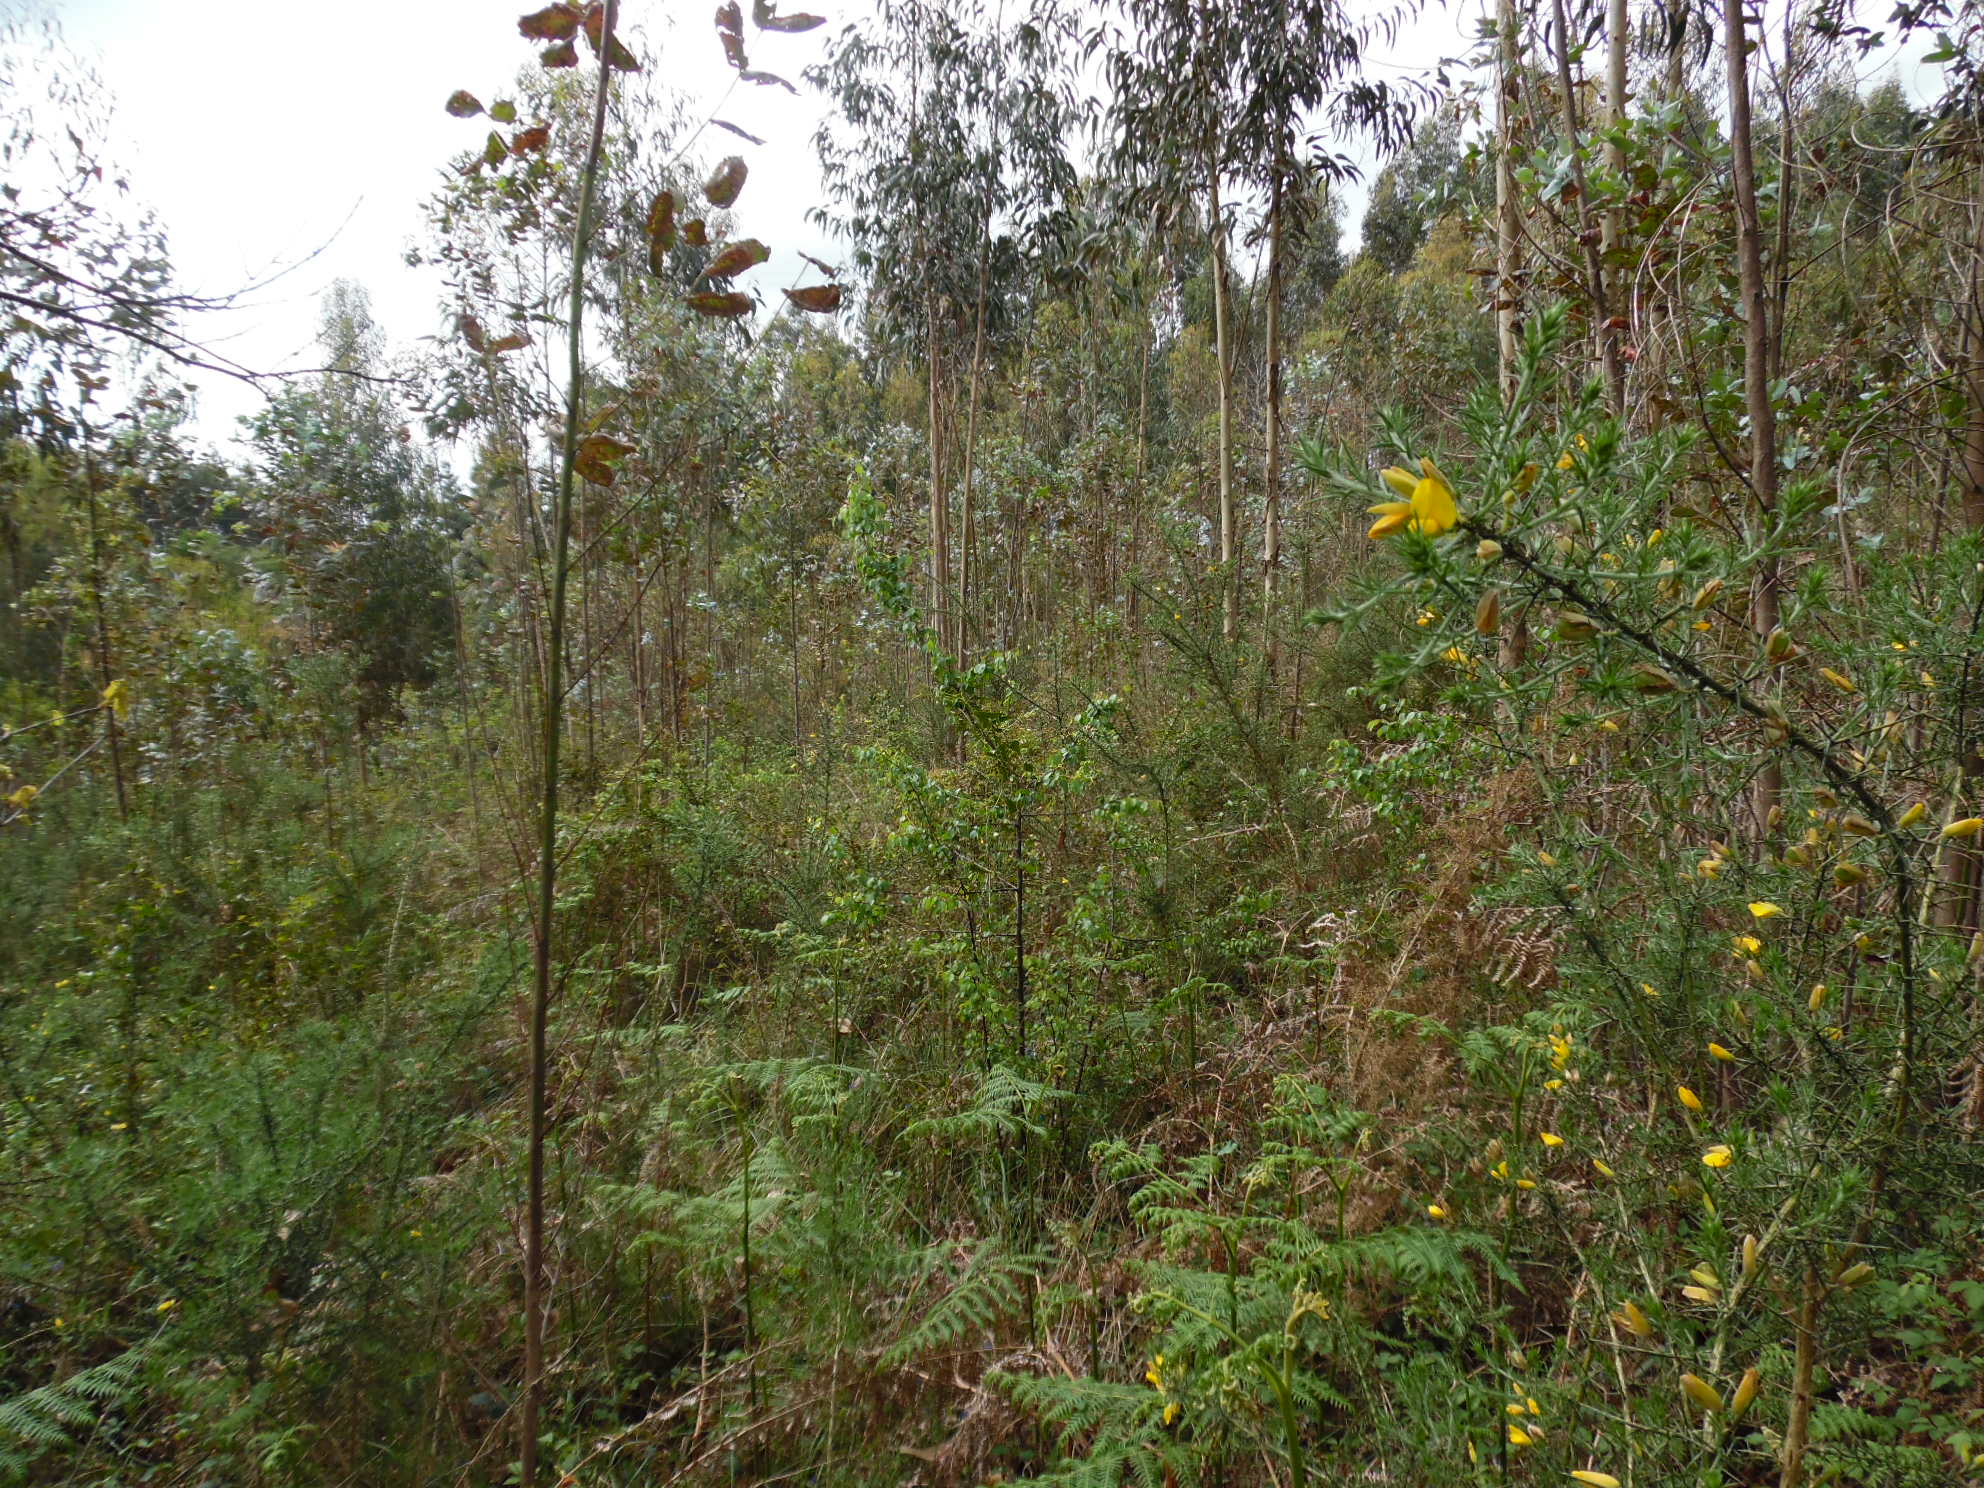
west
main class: Woodland
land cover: Broadleaved woodland
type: exotic forest
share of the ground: > 75 %
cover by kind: broadleaved forest trees 95 %, shrubs 5 %
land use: Forestry
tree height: > 5 m
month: April
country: ES
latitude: 43.5597
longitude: -5.8746
